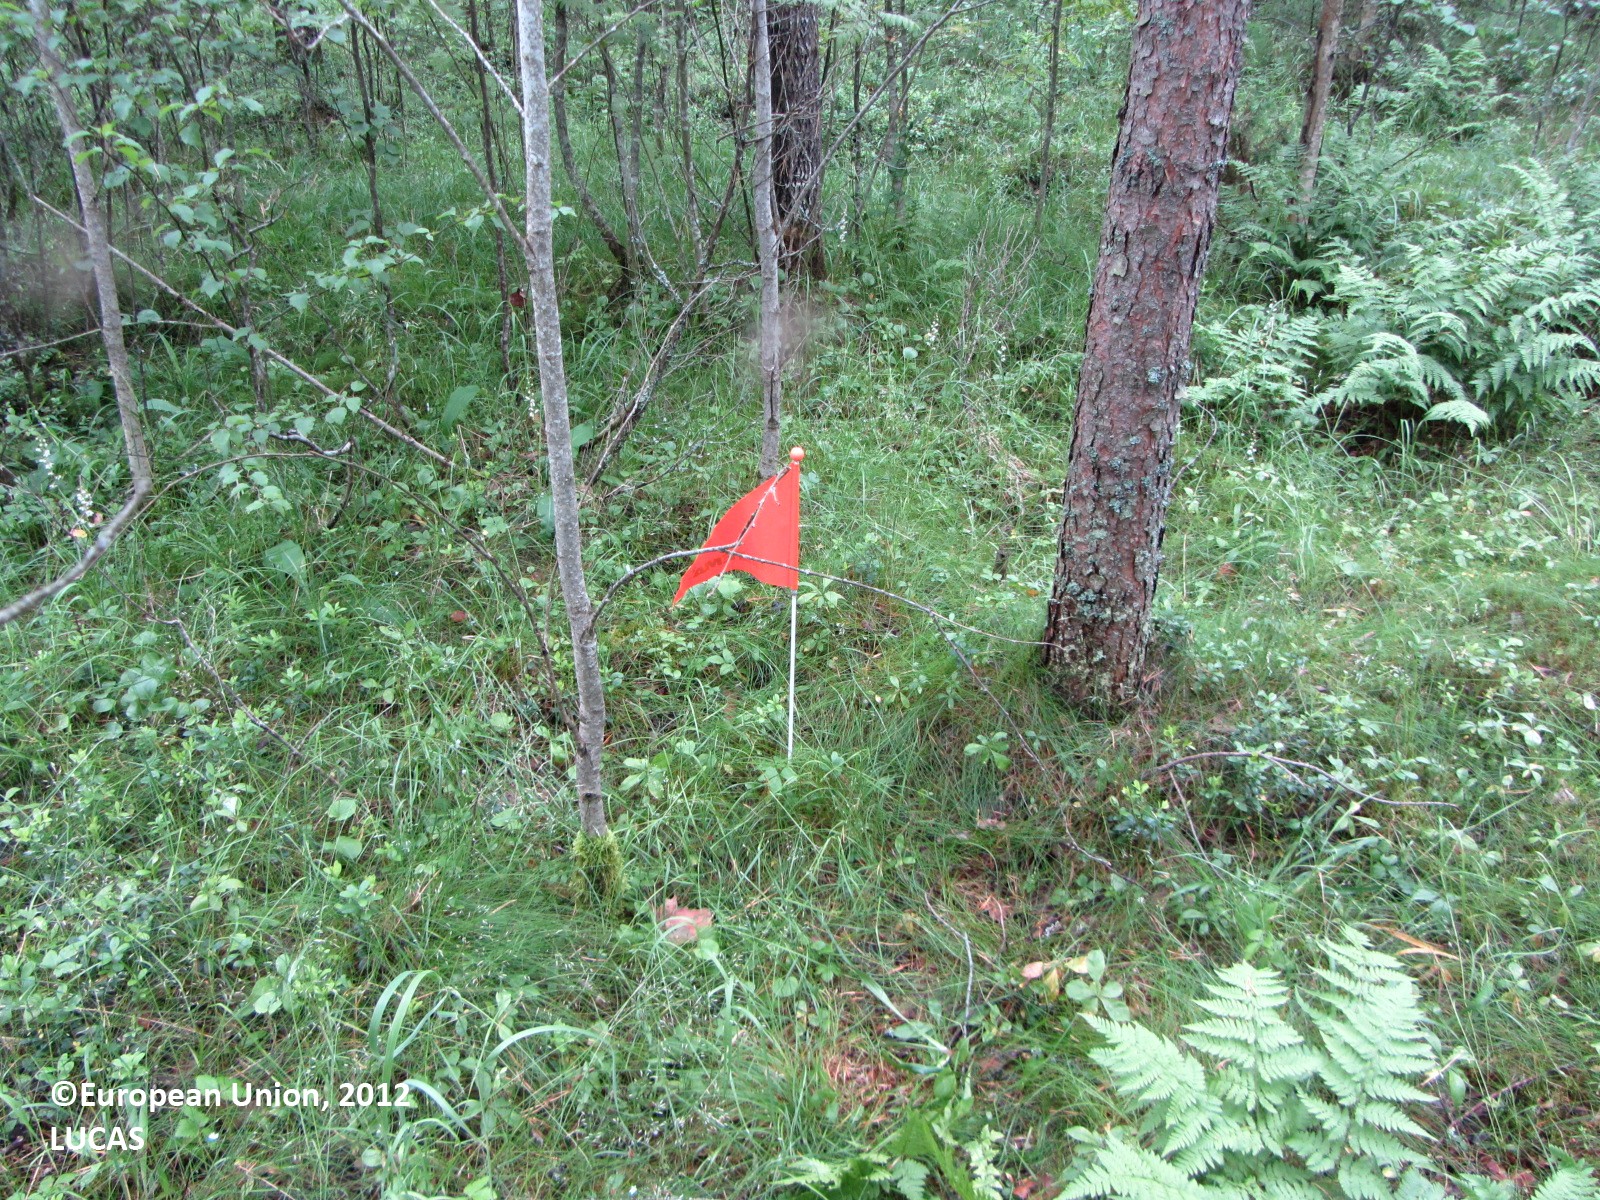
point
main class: Woodland
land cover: Pine dominated mixed woodland
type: boreal forest
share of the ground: > 75 %
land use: Forestry
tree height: > 5 m
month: July
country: FI
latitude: 63.7391
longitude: 25.5149
